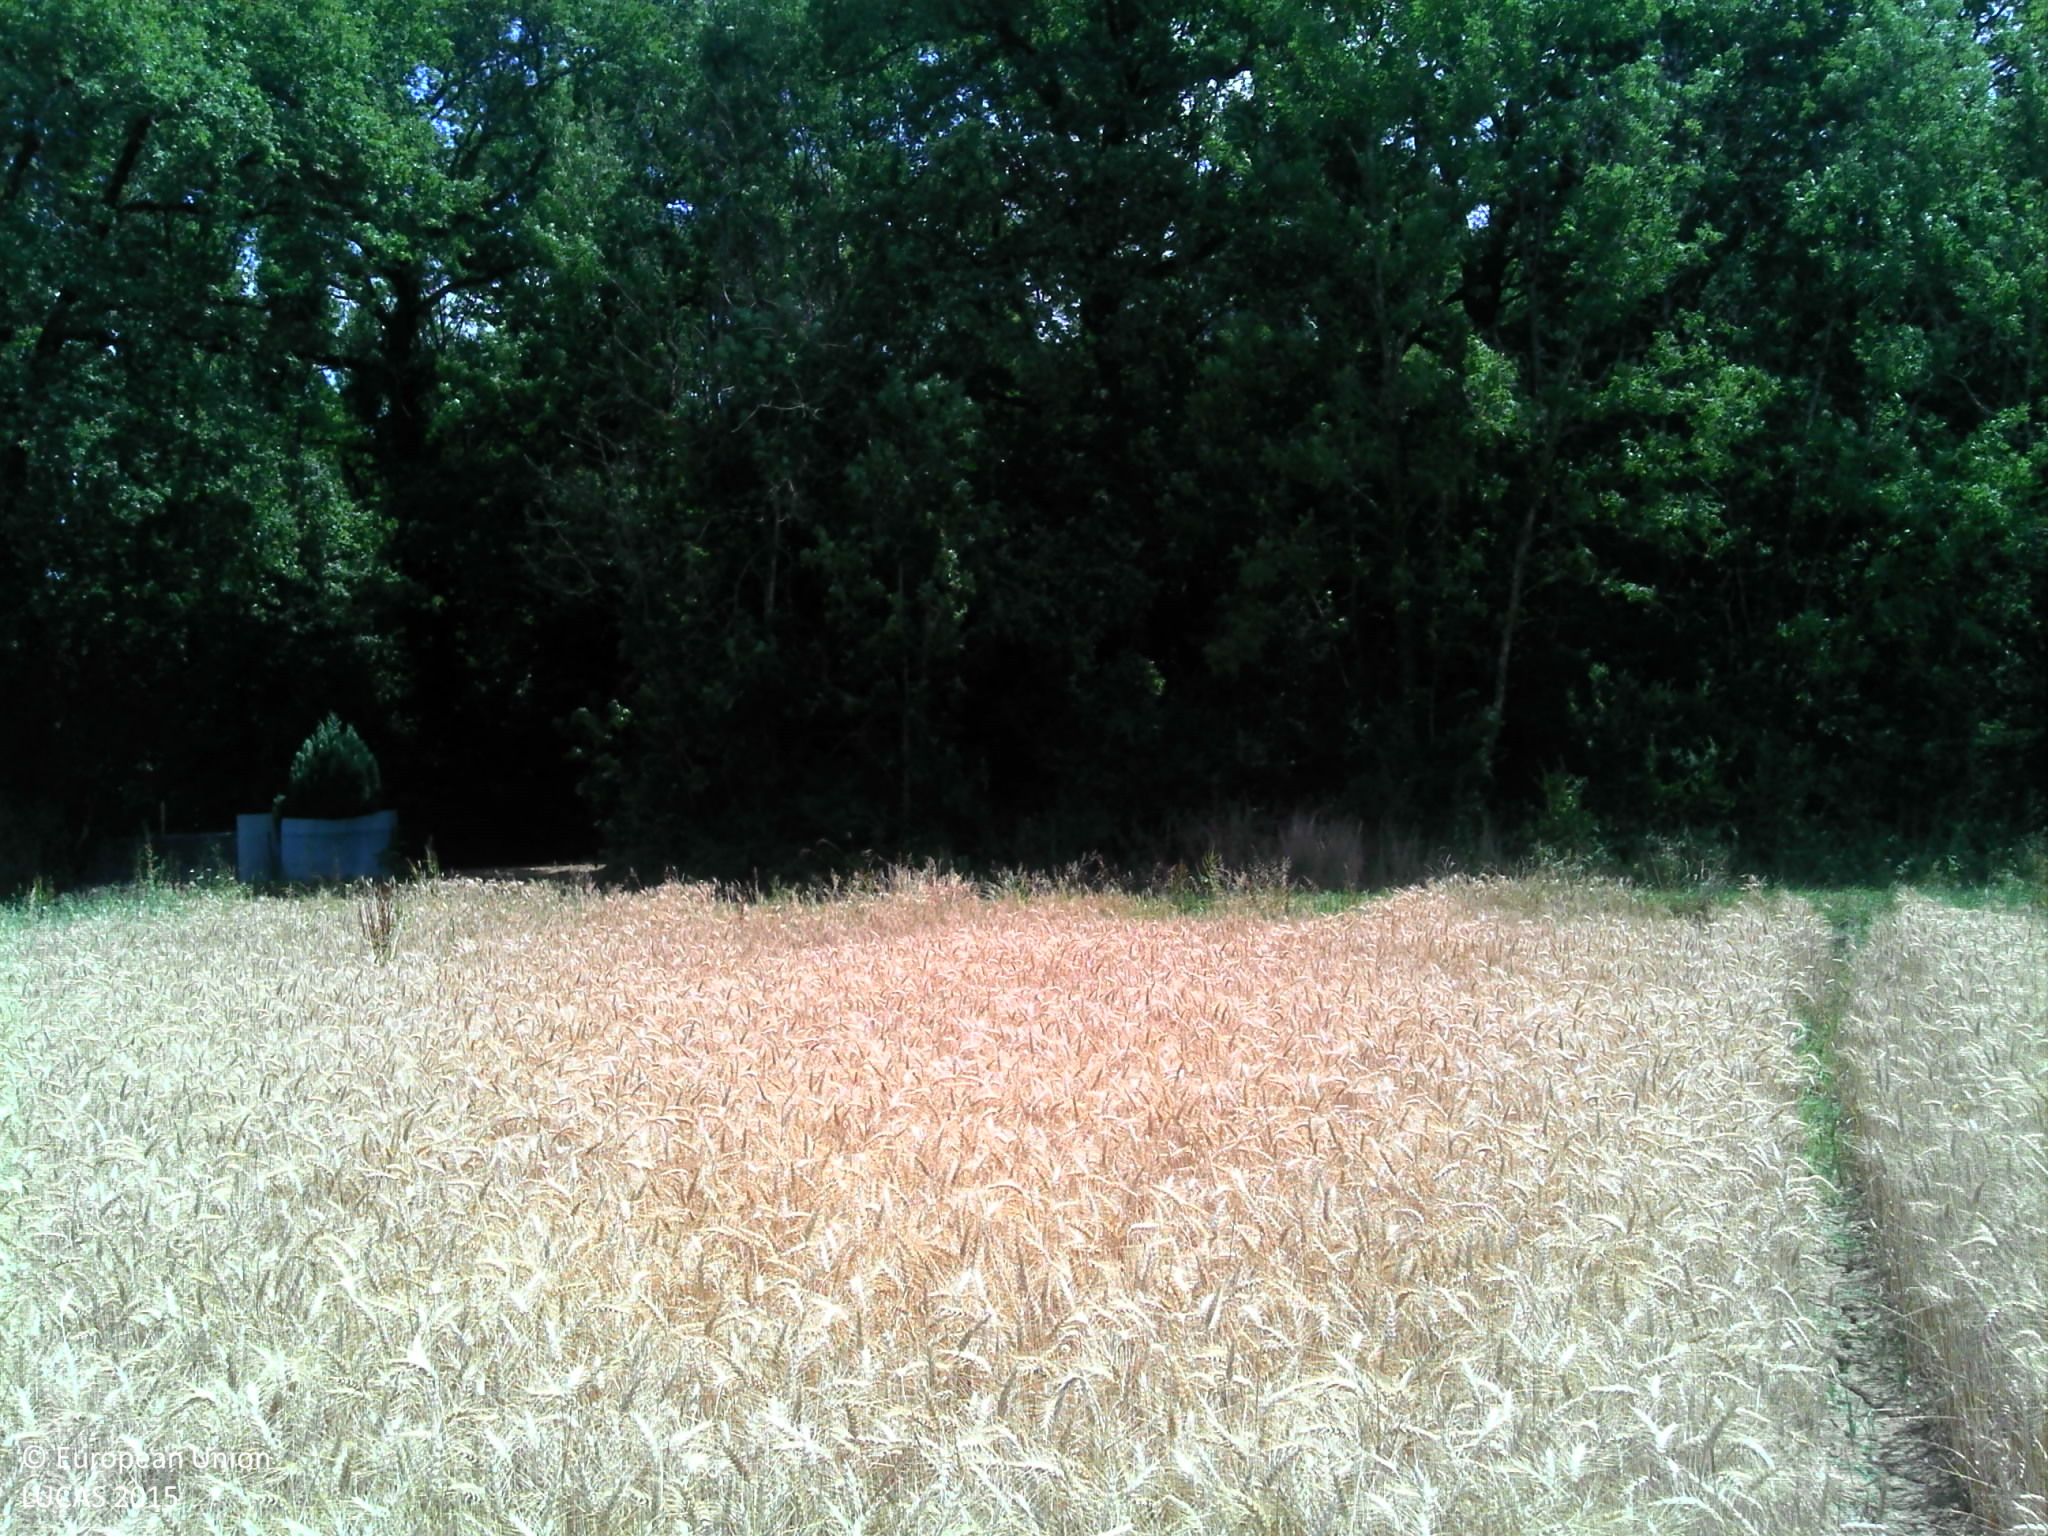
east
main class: Cropland
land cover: Durum wheat
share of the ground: > 75 %
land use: Agriculture (excluding fallow land and kitchen gardens)
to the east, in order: Durum wheat; Grassland without tree/shrub cover; Broadleaved woodland; Paved roads, cycling and walking lanes; Broadleaved woodland; Grassland without tree/shrub cover; Abandoned hedges; Fences; Inland fresh water bodies; Grassland with sparse tree/shrub cover; Fences; Single bushes/trees; Artificial constructions in urban areas; Other bare soil; Fences; Broadleaved woodland; Tracks; Broadleaved woodland
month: July
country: FR
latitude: 46.3225
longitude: 6.2757
